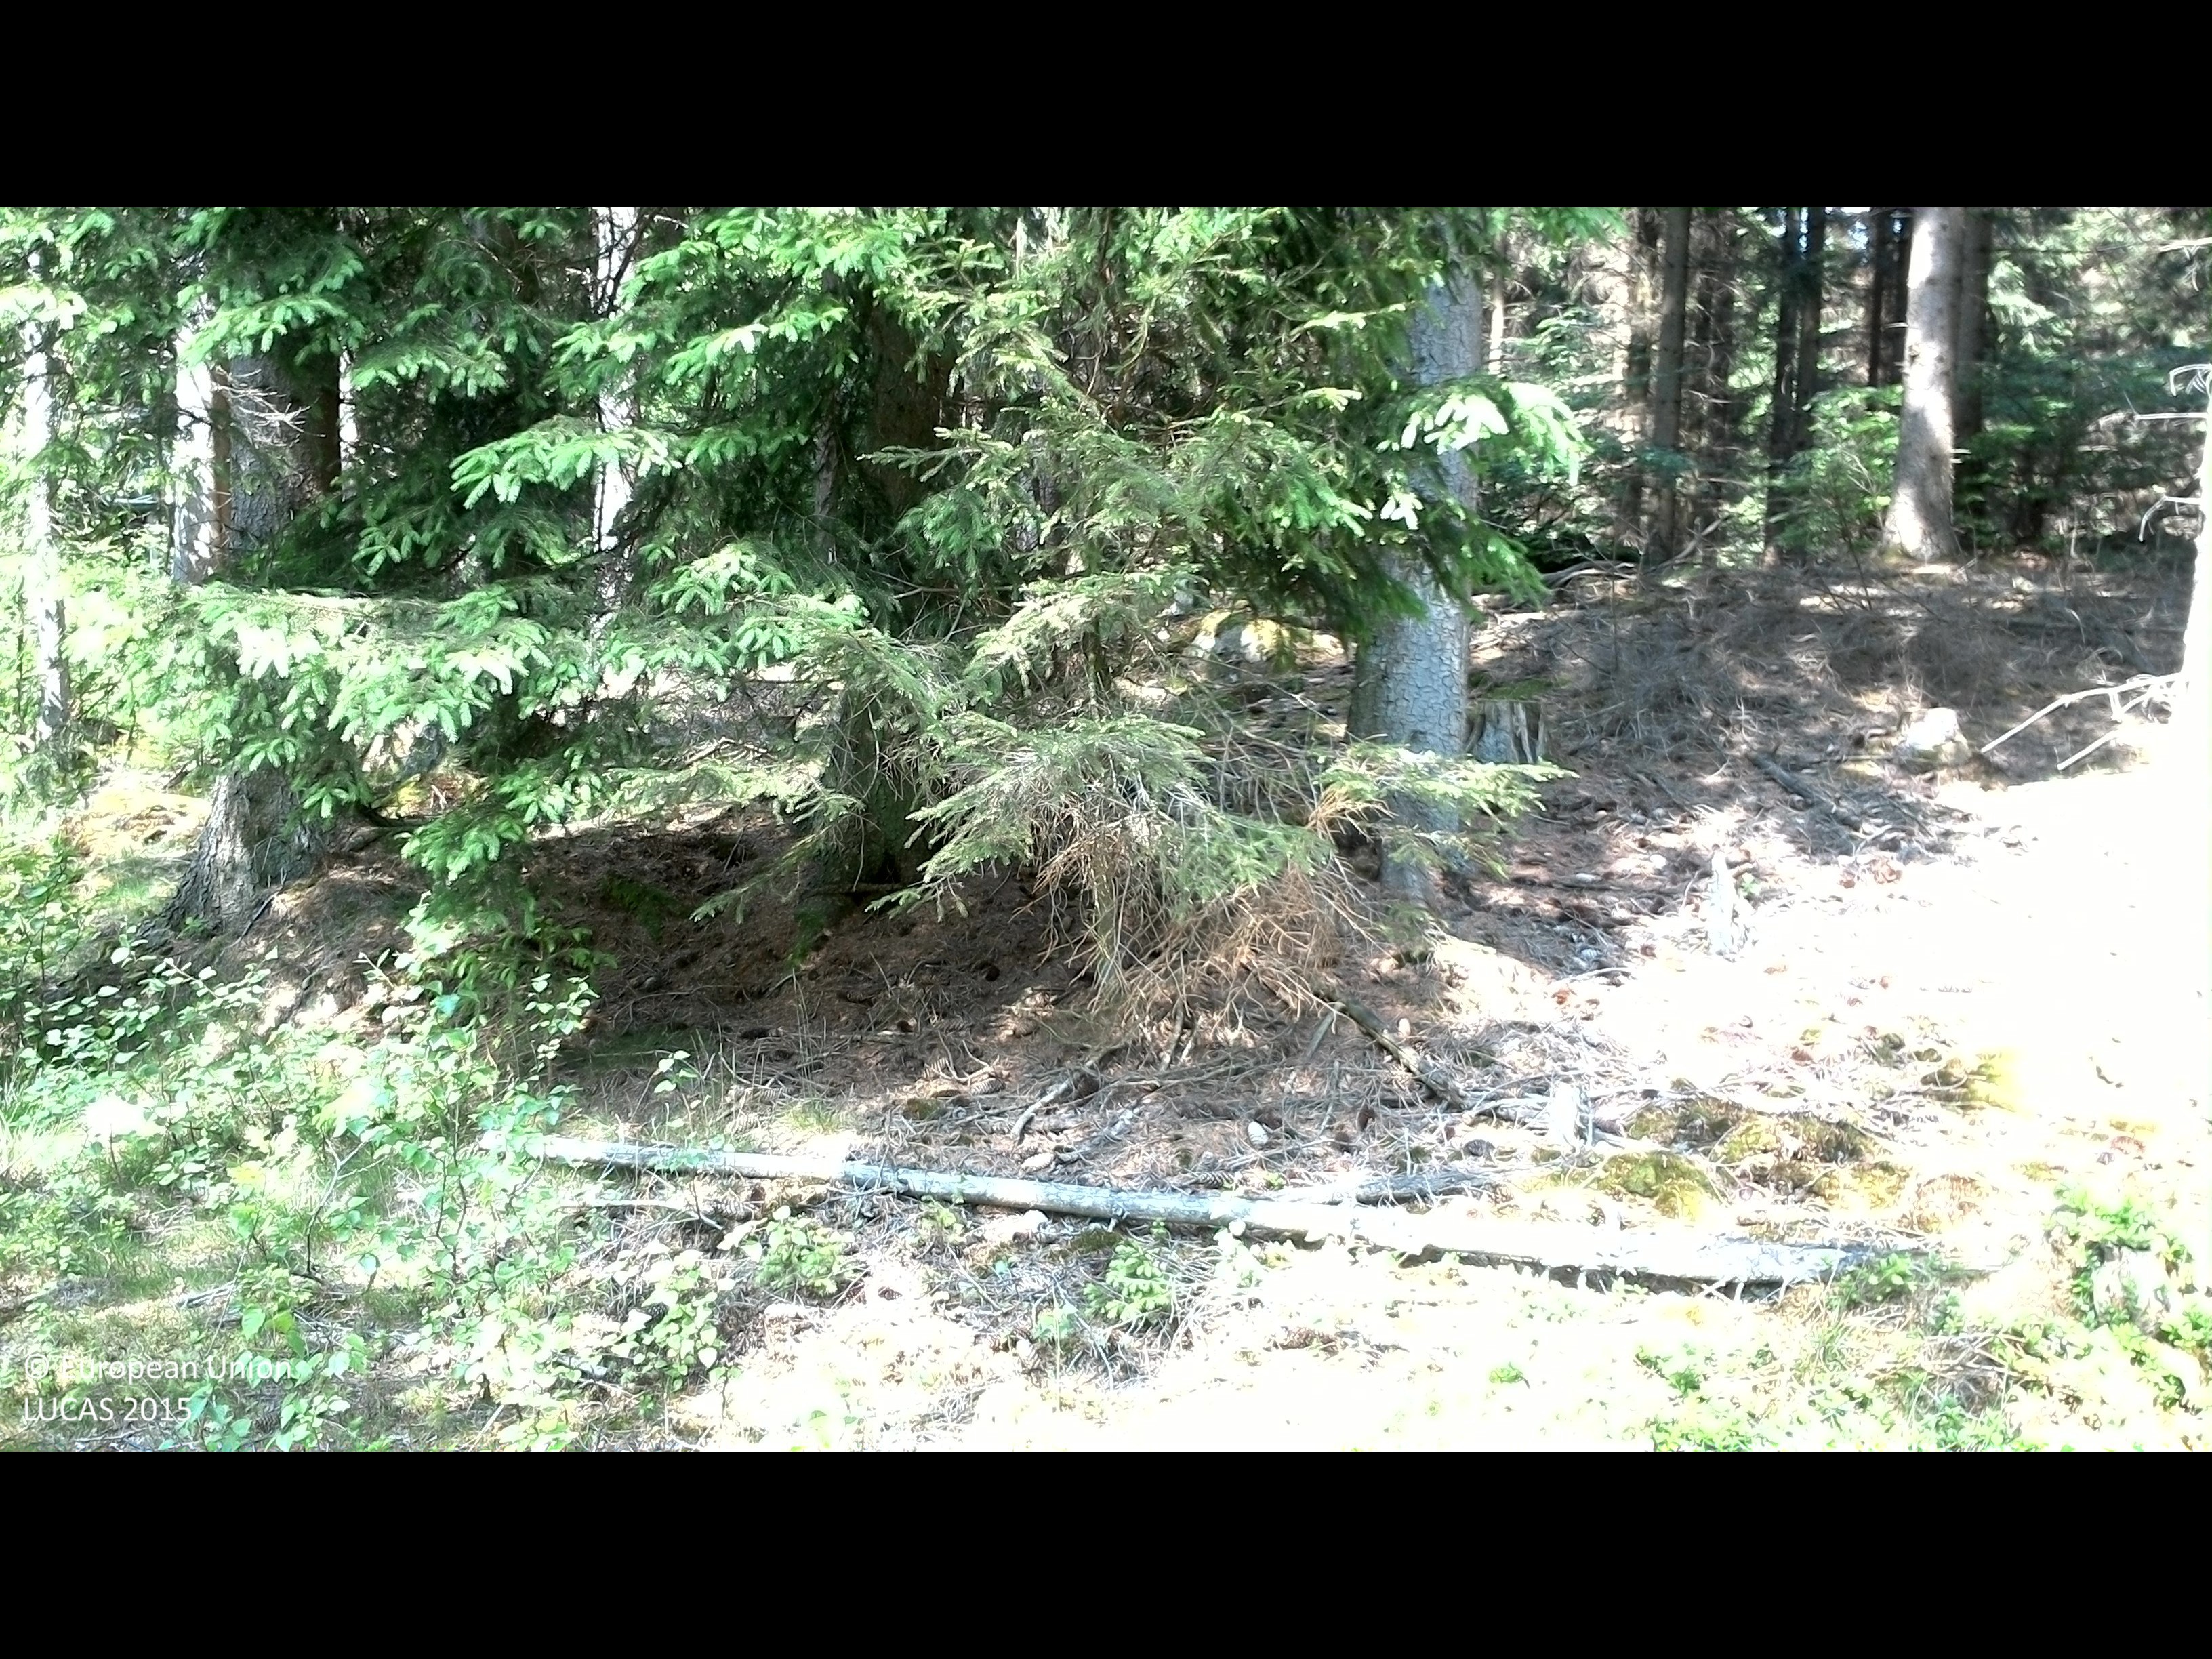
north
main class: Woodland
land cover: Spruce dominated mixed woodland
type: boreal forest
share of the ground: > 75 %
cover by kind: coniferous forest trees 45 %, broadleaved forest trees 35 %, shrubs 10 %, herbaceous plants 10 %
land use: Forestry
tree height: > 5 m
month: June
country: SE
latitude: 55.8014
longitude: 14.0023
